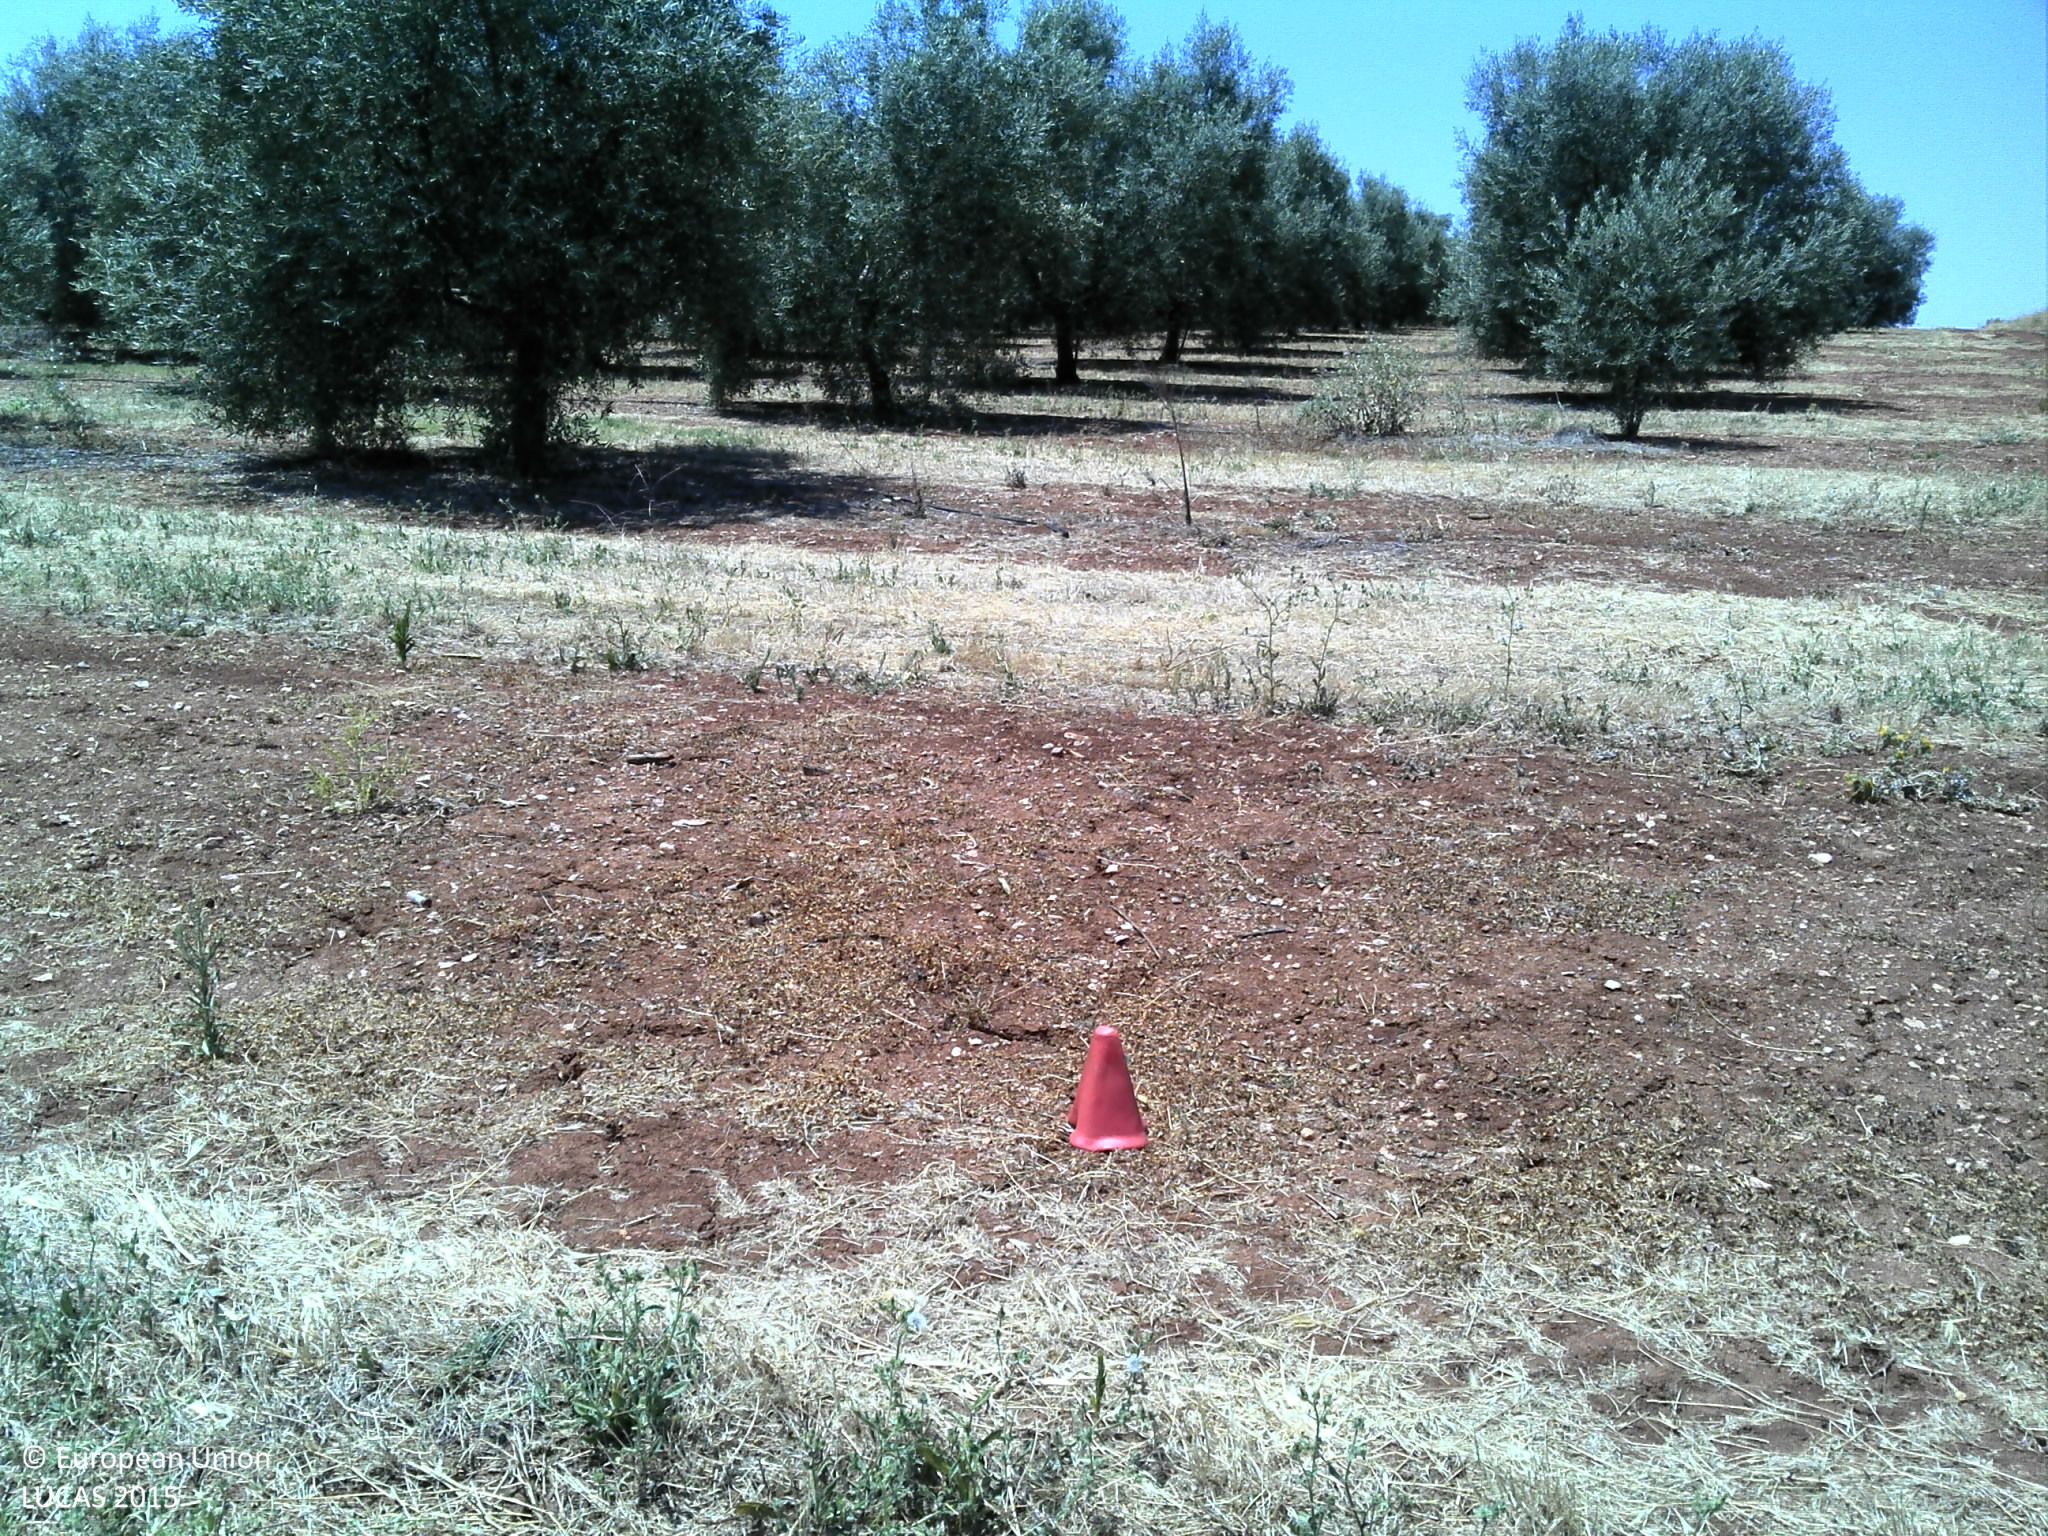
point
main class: Cropland
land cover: Olive groves
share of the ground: 25 - 50 %
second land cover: Grassland without tree/shrub cover
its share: 10 - 25 %
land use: Agriculture (excluding fallow land and kitchen gardens)
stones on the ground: < 10 %
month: June
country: PT
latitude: 38.0201
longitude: -7.5748
